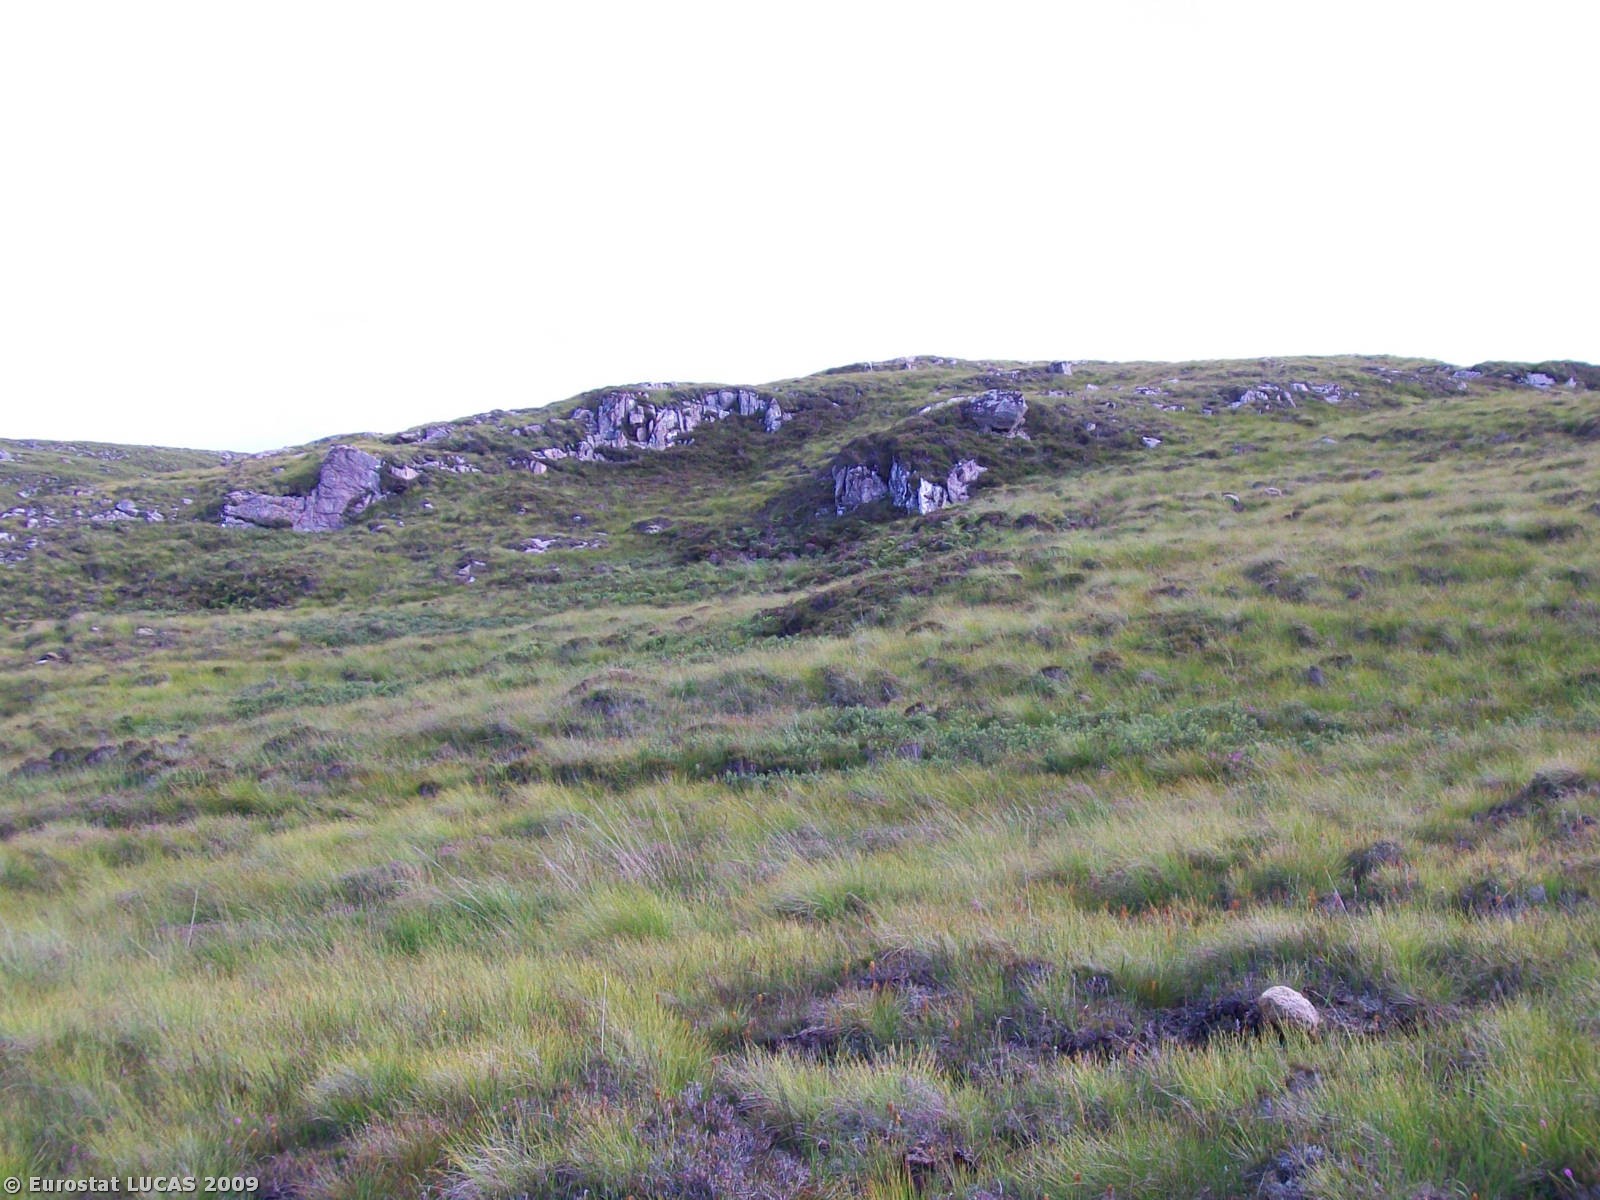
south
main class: Shrubland
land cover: Shrubland without tree cover
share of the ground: > 75 %
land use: Unused
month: July
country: GB
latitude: 58.5444
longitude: -4.6752
